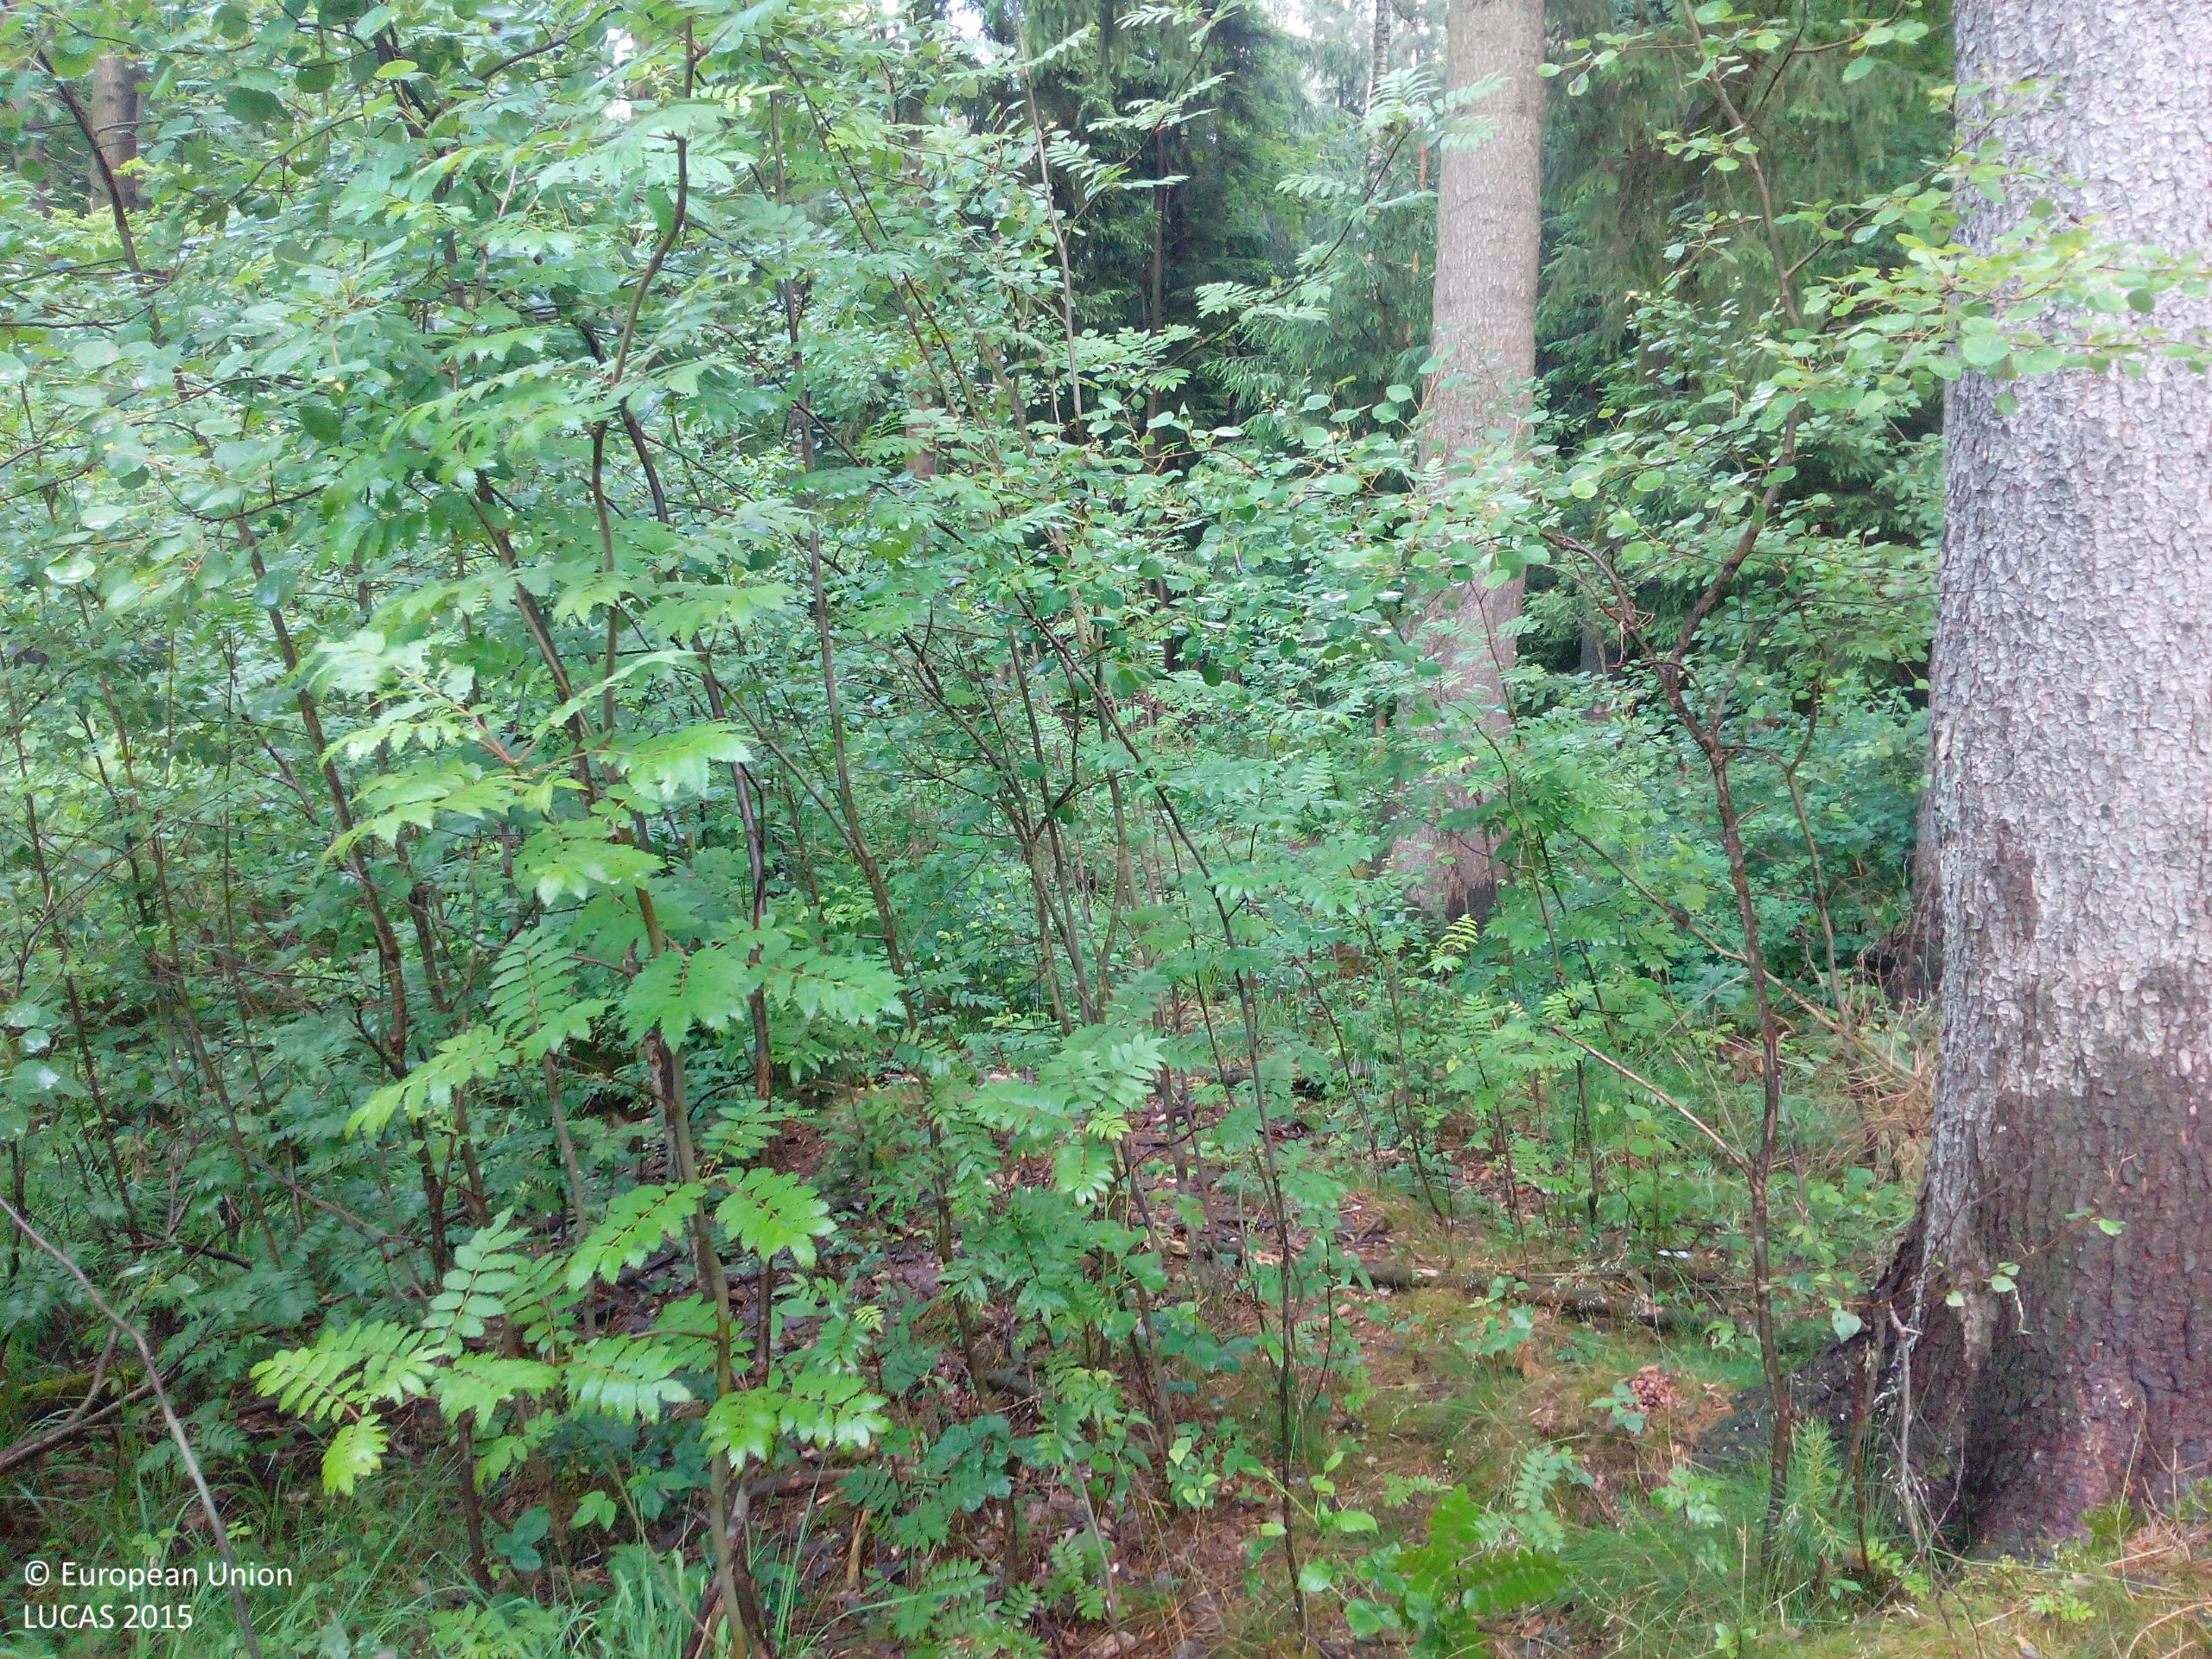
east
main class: Woodland
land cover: Spruce dominated mixed woodland
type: hemiboreal forest and nemoral coniferous forest and mixed broadleaved-coniferous forest
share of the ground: > 75 %
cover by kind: broadleaved forest trees 55 %, coniferous forest trees 25 %, shrubs 20 %
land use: Forestry
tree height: > 5 m
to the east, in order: Spruce dominated mixed woodland; Tracks; Pine dominated mixed woodland; Spruce dominated mixed woodland; Ditches and canals; Abandoned hedges; Fences; Grassland without tree/shrub cover; Fences; Ditches and canals; Pine dominated mixed woodland; Broadleaved woodland; Ditches and canals; Fences; Broadleaved woodland; Grassland without tree/shrub cover
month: June
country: DE
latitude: 51.1945
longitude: 13.9934
